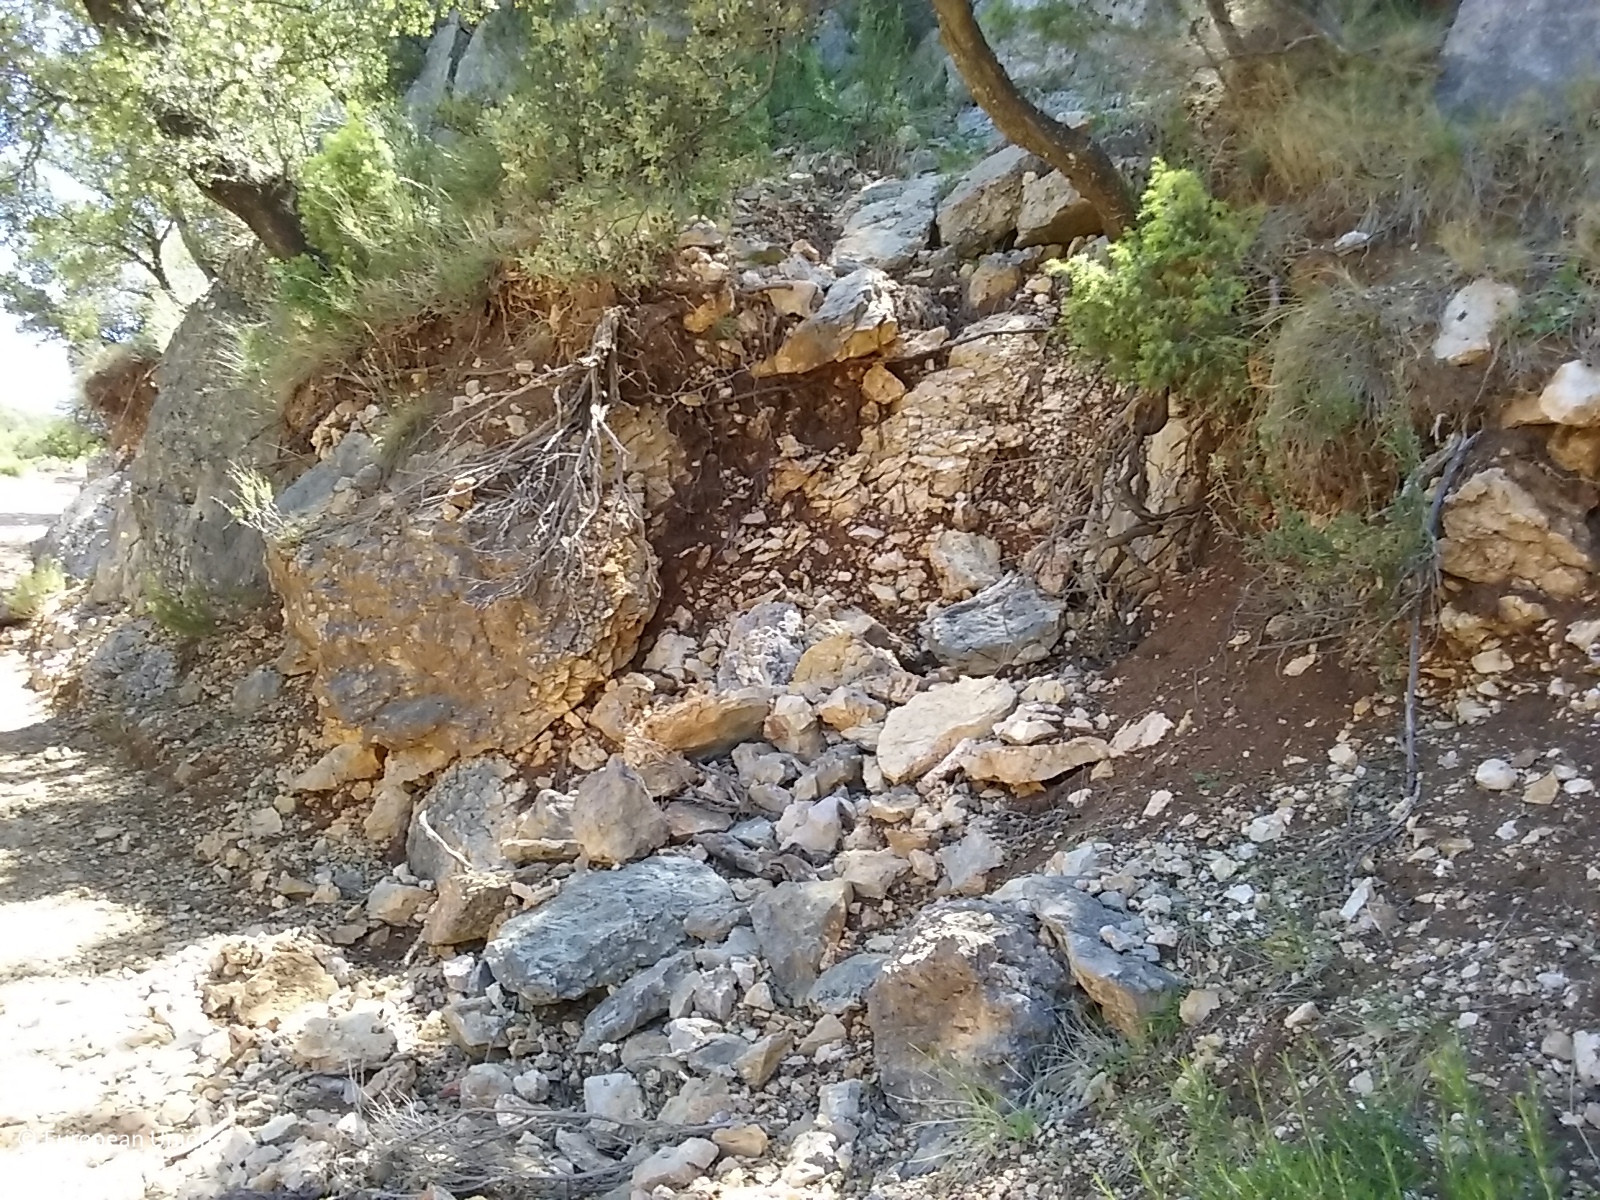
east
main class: Woodland
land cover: Pine dominated mixed woodland
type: coniferous forest of the mediterranean region
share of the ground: > 75 %
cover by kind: coniferous forest trees 40 %, broadleaved forest trees 40 %, shrubs 10 %, unconsolidated bare surface 10 %
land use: Forestry
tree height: > 5 m
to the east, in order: Pine dominated mixed woodland; Tracks; Broadleaved woodland
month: June
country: ES
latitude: 40.6166
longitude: 0.0526
